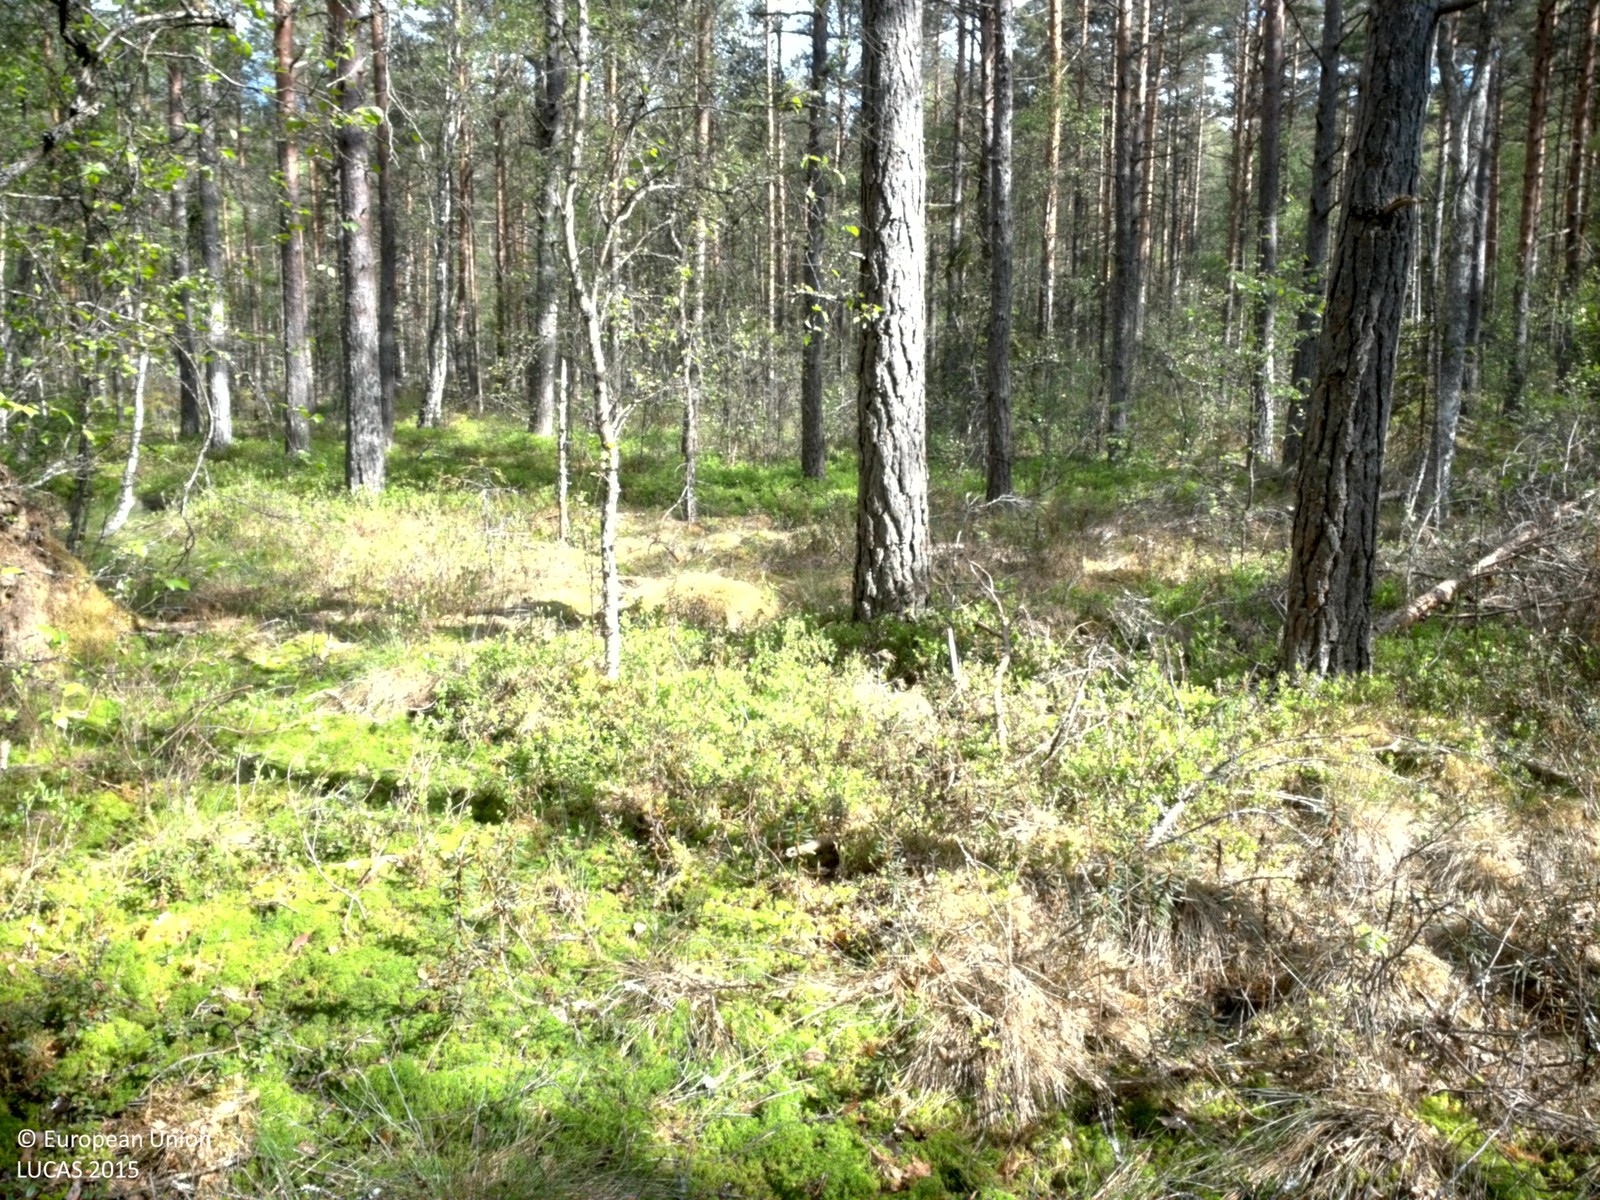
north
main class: Woodland
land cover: Pine dominated mixed woodland
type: boreal forest
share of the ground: > 75 %
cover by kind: coniferous forest trees 60 %, broadleaved forest trees 25 %, shrubs 5 %, herbaceous plants 5 %, lichens and mosses 5 %
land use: Forestry
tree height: > 5 m
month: May
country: SE
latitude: 56.4732
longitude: 15.3397
